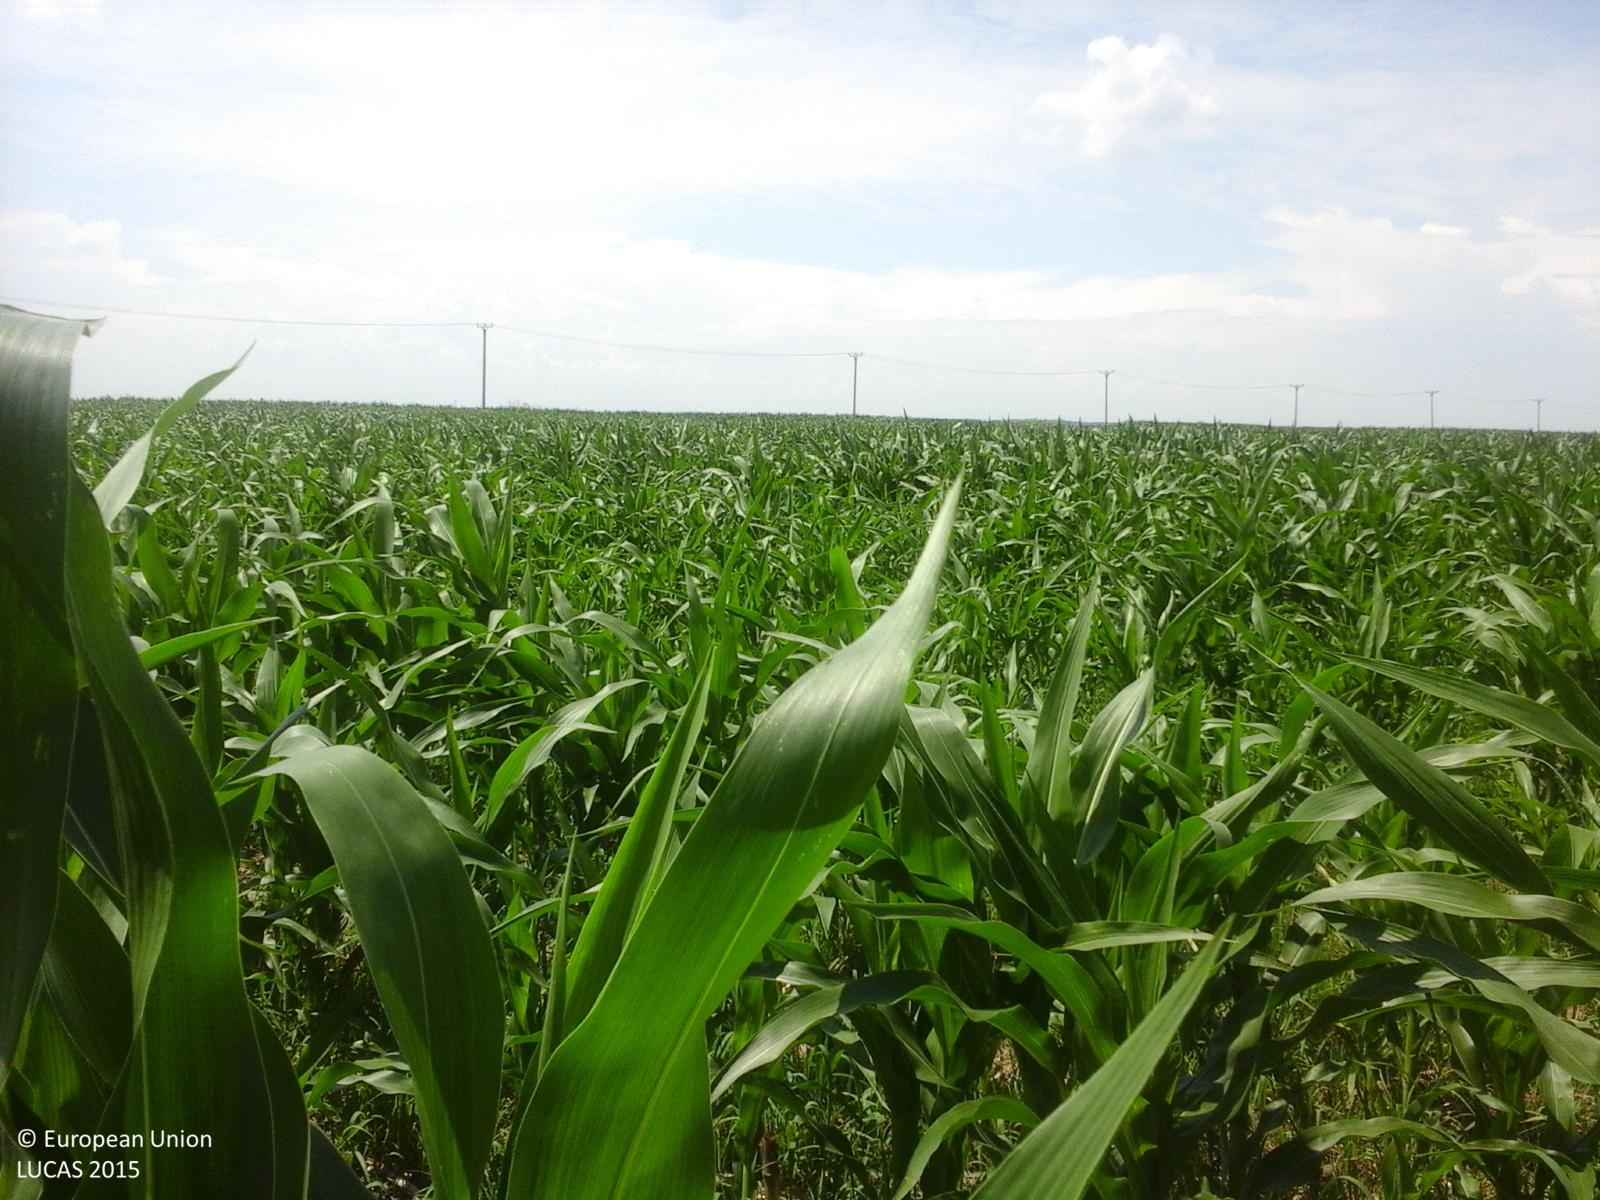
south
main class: Cropland
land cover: Maize
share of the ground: > 75 %
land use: Agriculture (excluding fallow land and kitchen gardens)
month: June
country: RO
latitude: 44.0951
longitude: 26.4352
